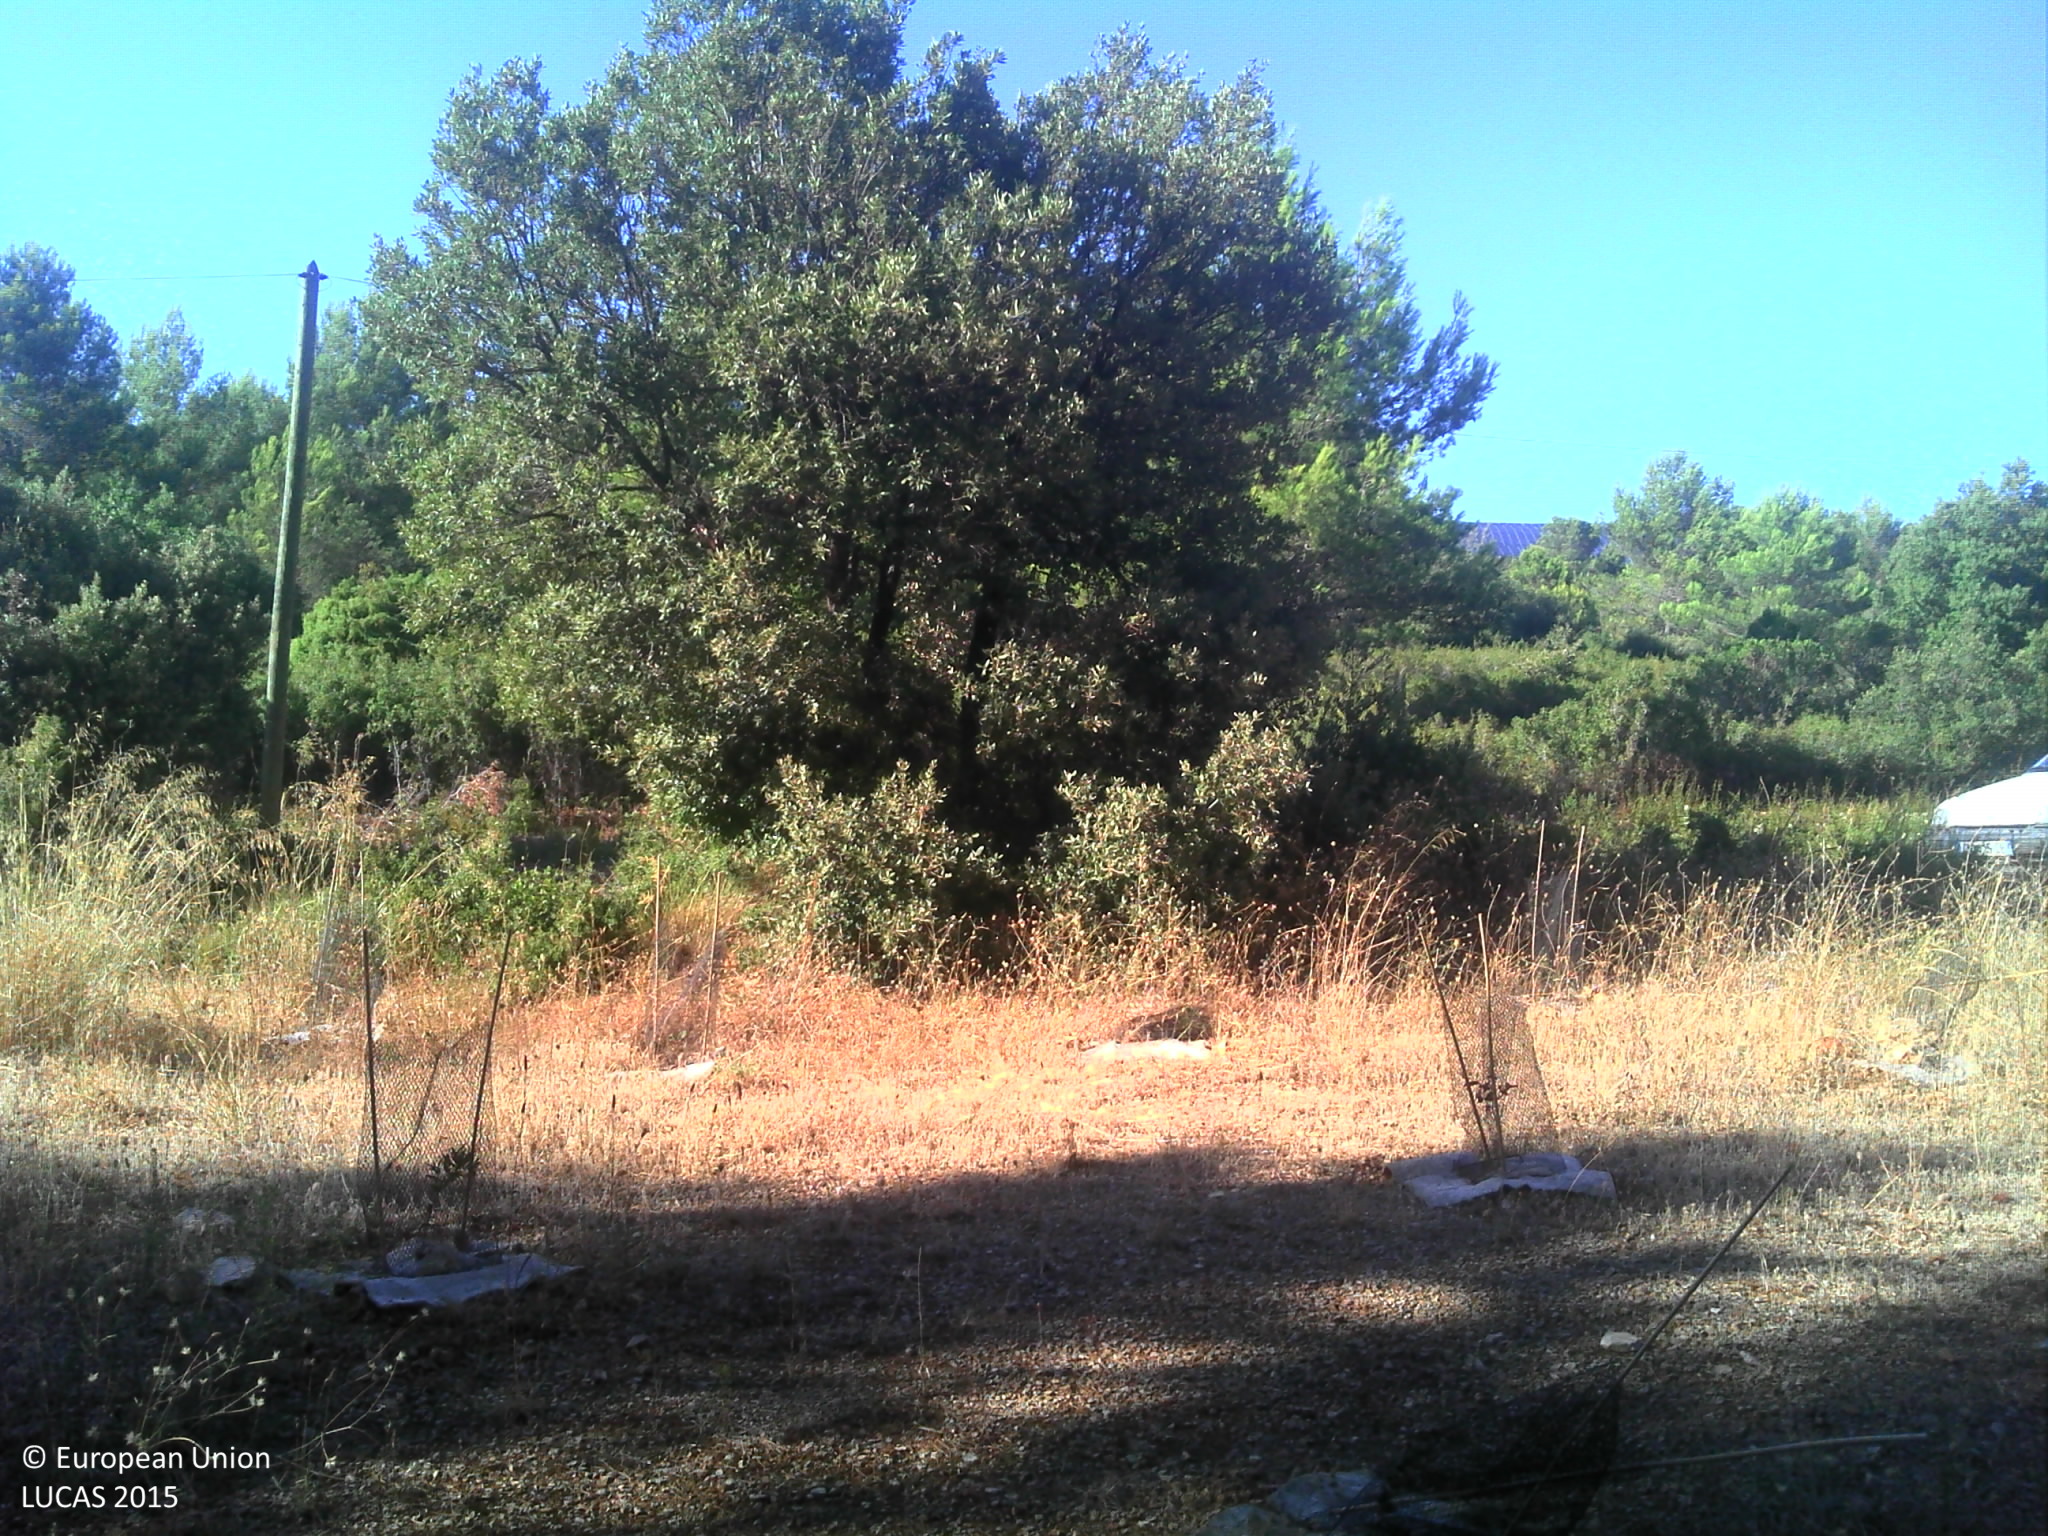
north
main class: Woodland
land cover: Pine dominated coniferous woodland
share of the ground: 50 - 75 %
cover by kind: coniferous forest trees 50 %, shrubs 35 %, herbaceous plants 10 %, consolidated bare surface 5 %
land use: Forestry
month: August
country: FR
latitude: 43.2873
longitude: 5.7335
